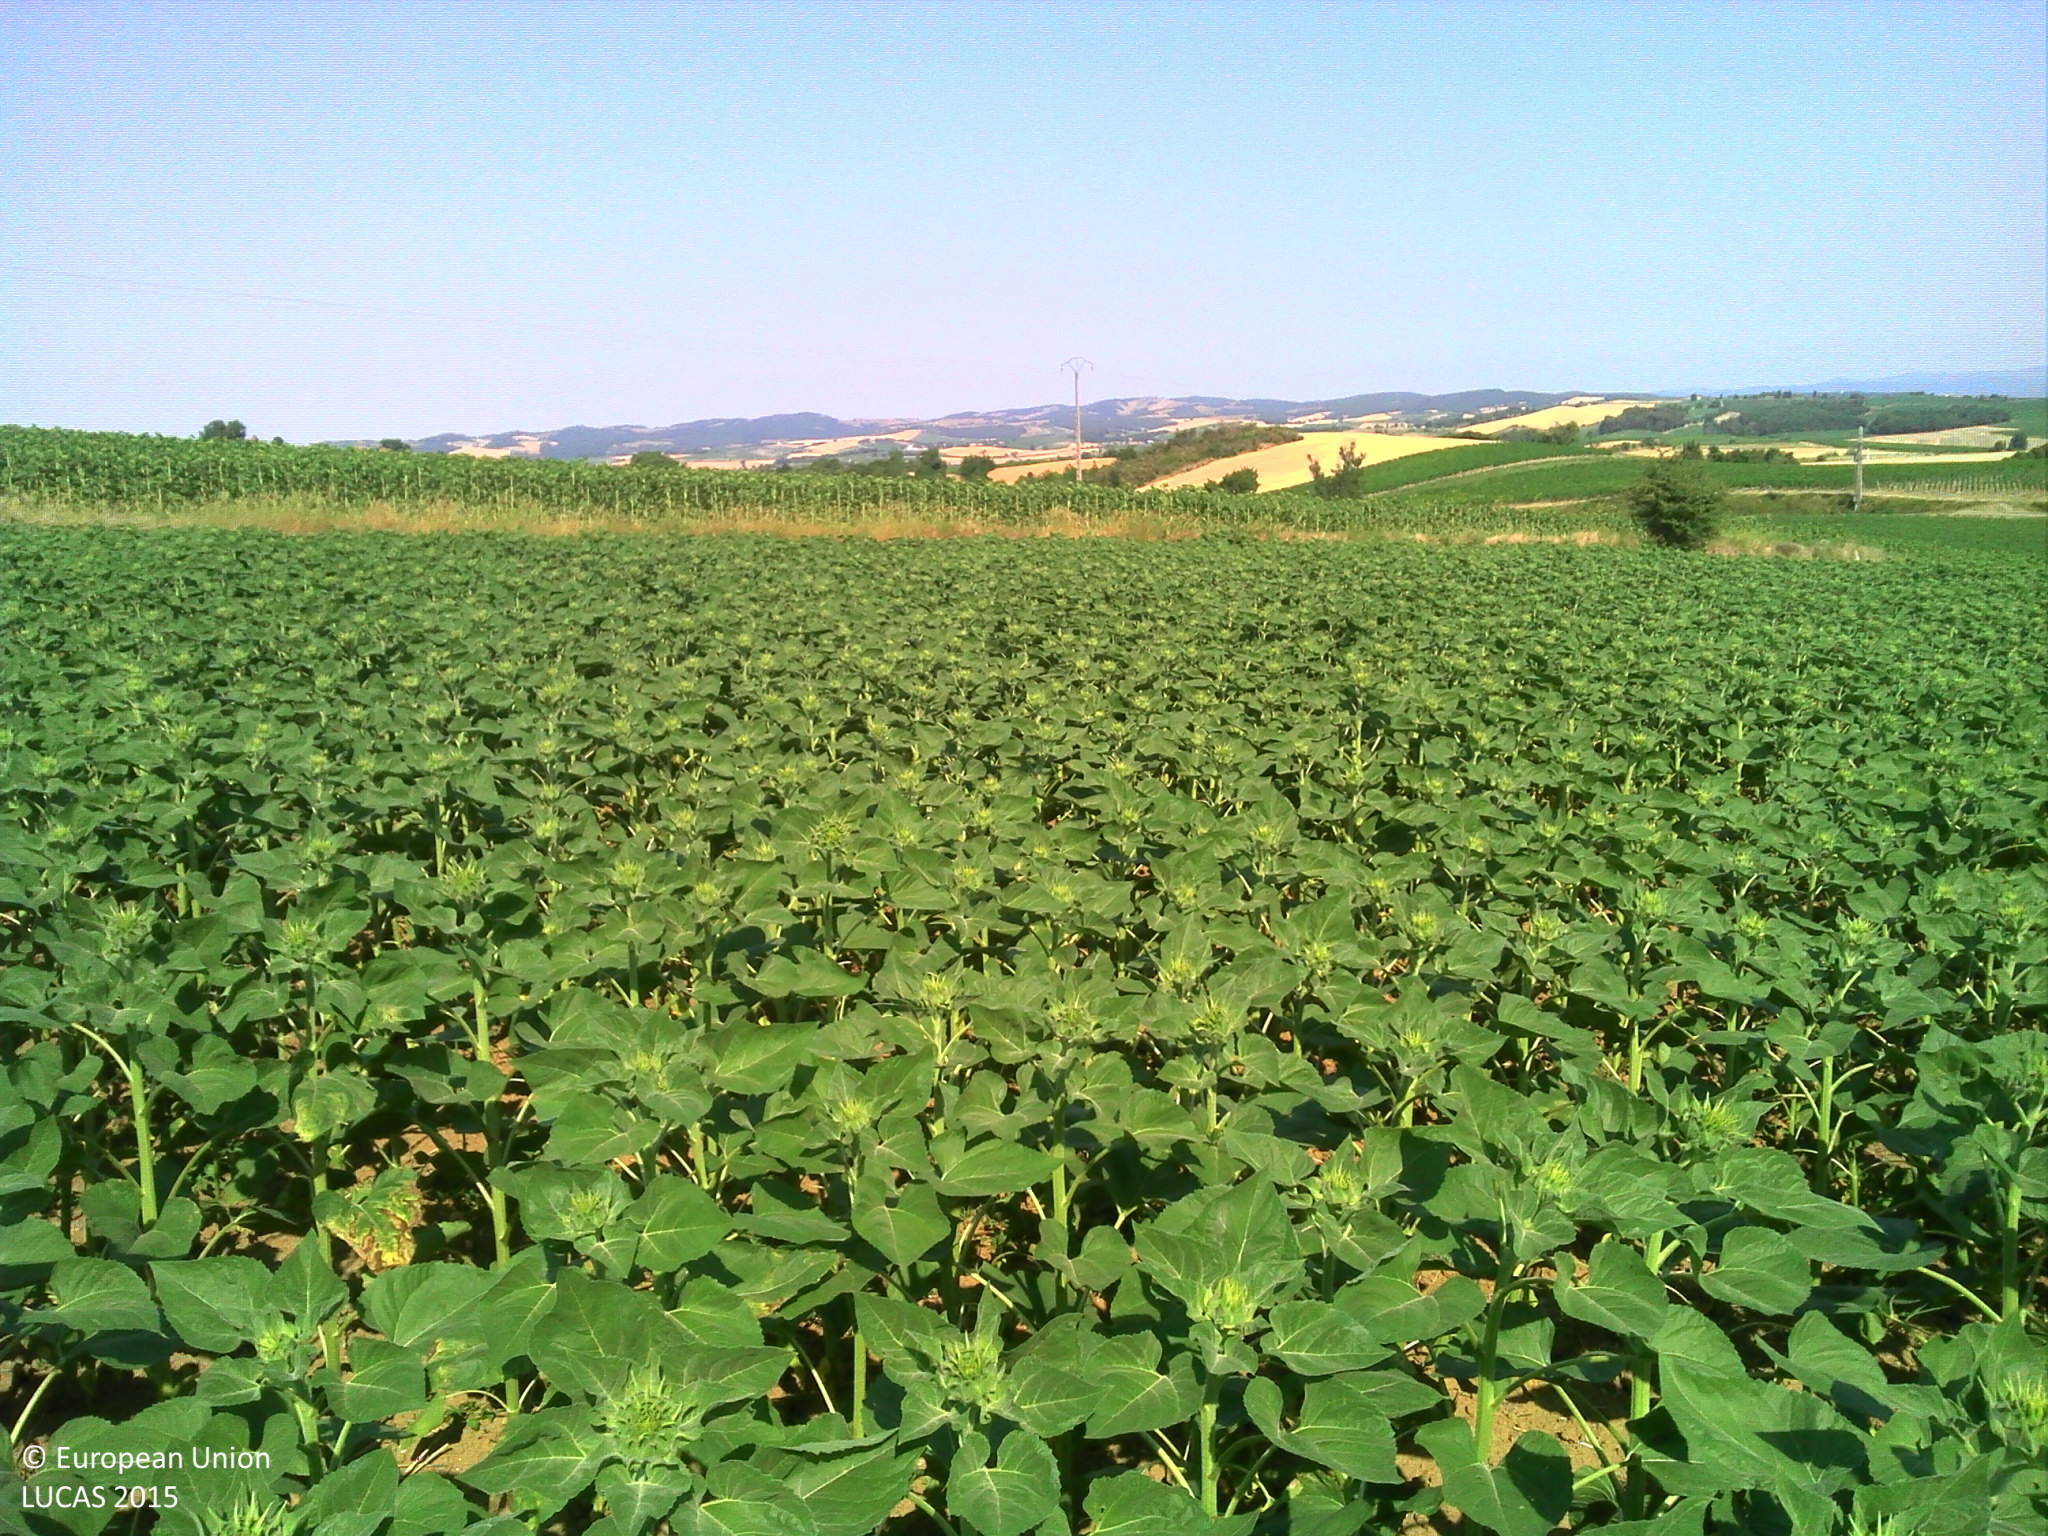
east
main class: Cropland
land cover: Sunflower
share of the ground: > 75 %
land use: Agriculture (excluding fallow land and kitchen gardens)
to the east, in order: Sunflower; Grass margins; Paved roads, cycling and walking lanes; Grass margins; Sunflower; Electric lines; Sunflower
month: June
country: FR
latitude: 43.1771
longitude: 2.0725
